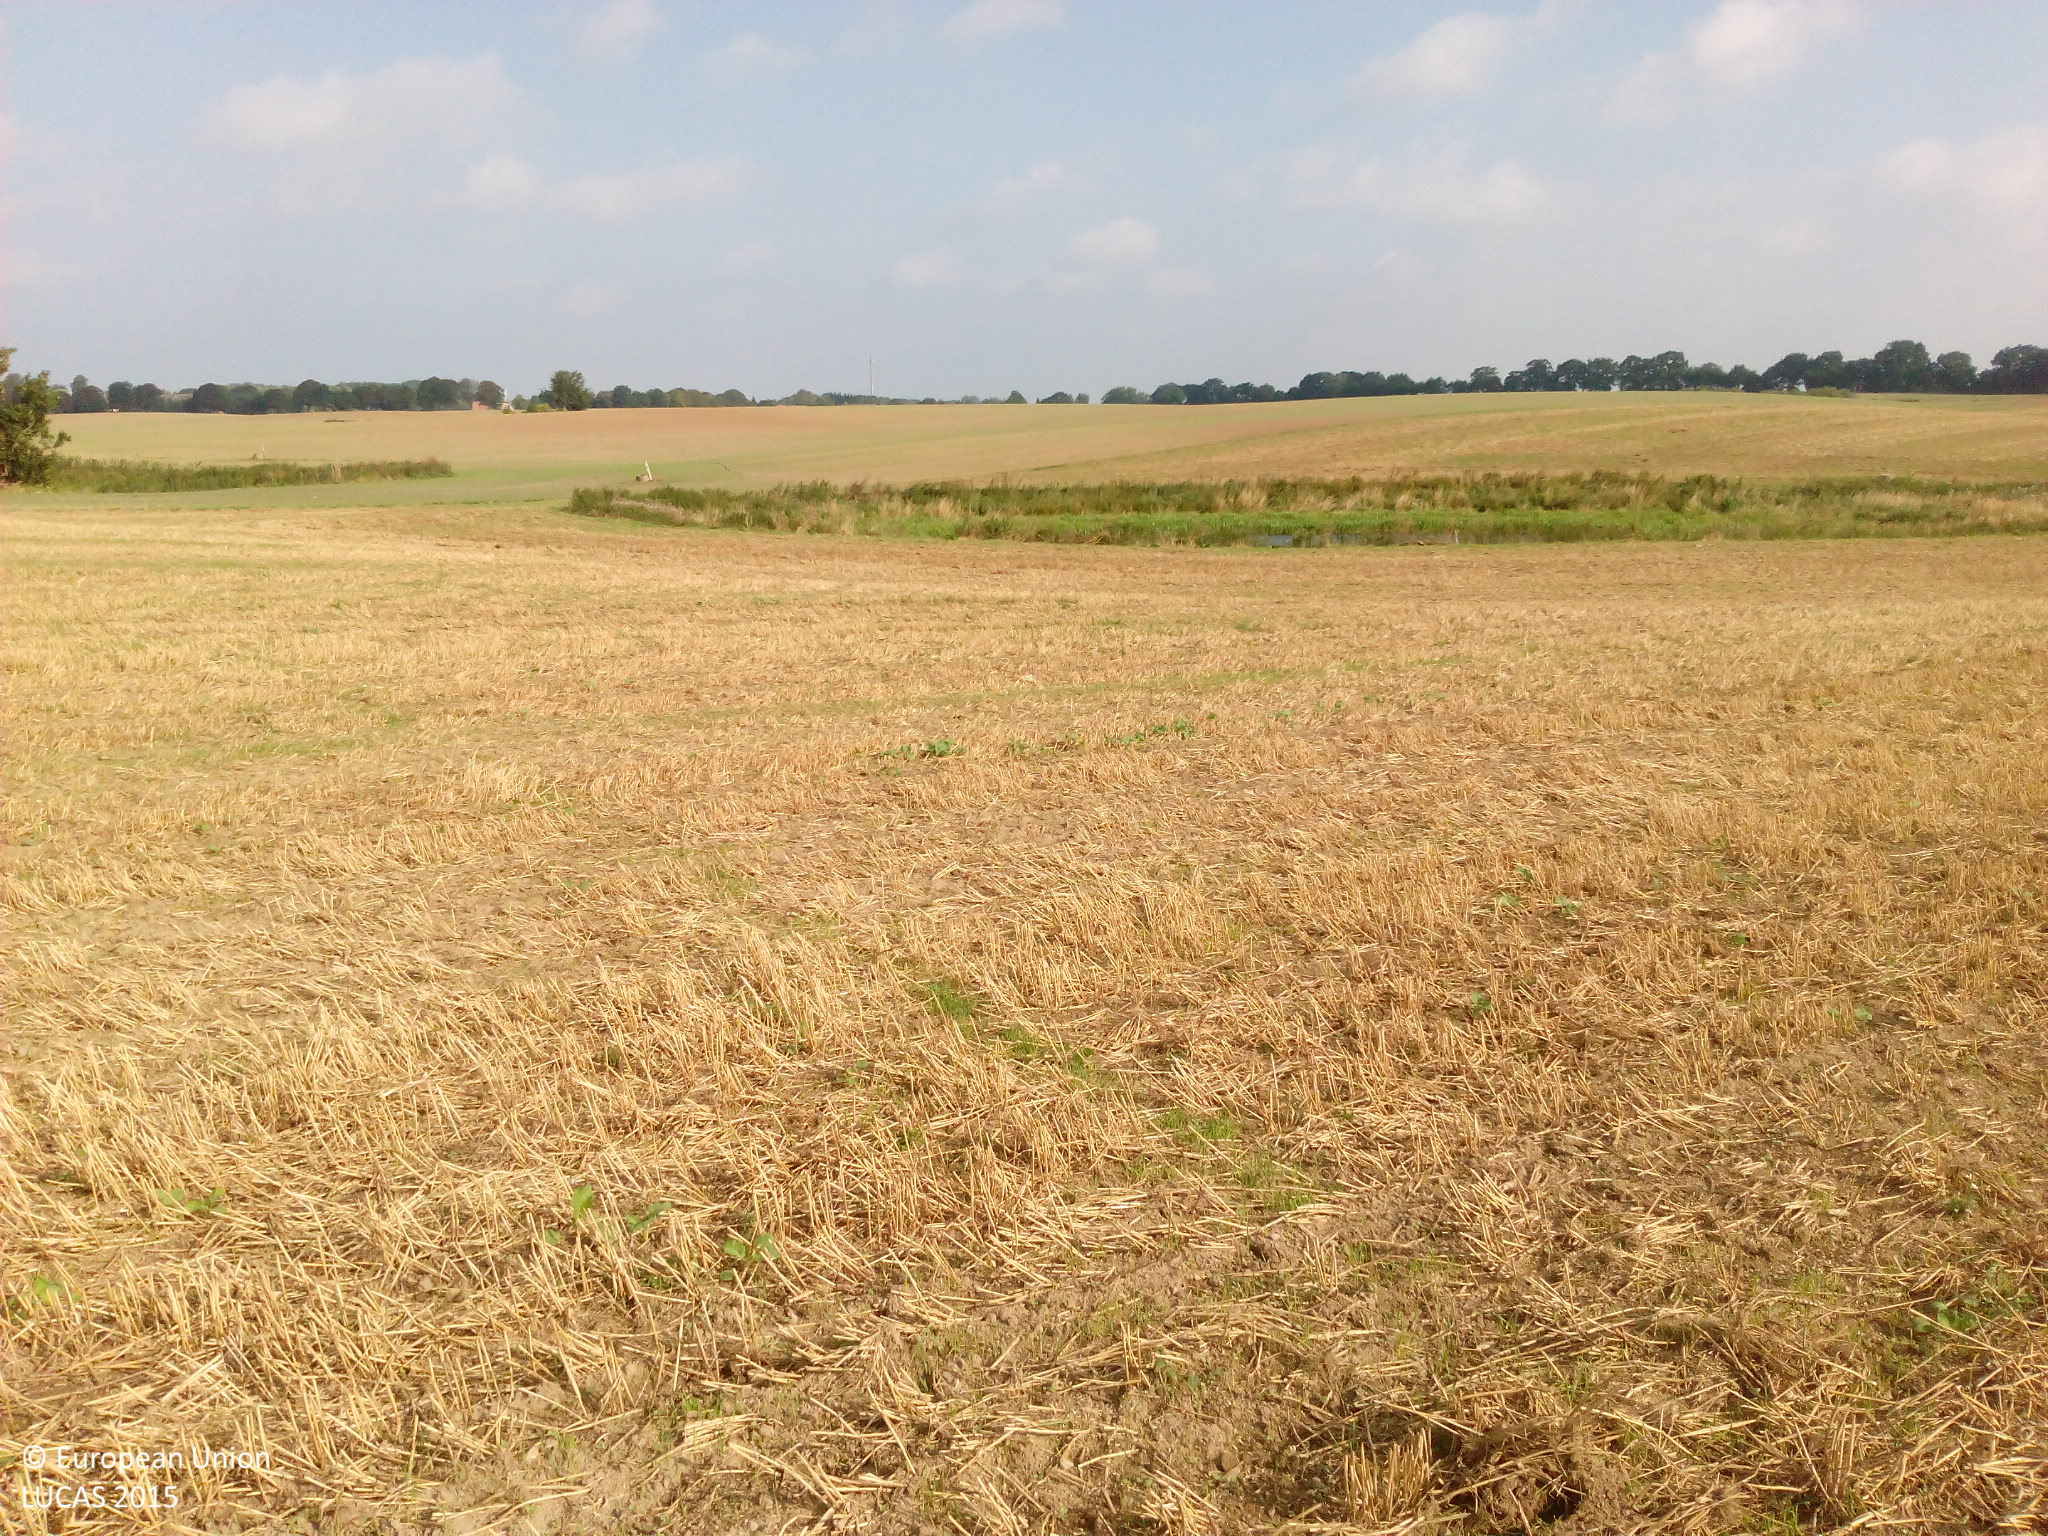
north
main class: Cropland
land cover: Common wheat
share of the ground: 50 - 75 %
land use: Agriculture (excluding fallow land and kitchen gardens)
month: September
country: DE
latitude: 54.1270
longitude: 12.7076
